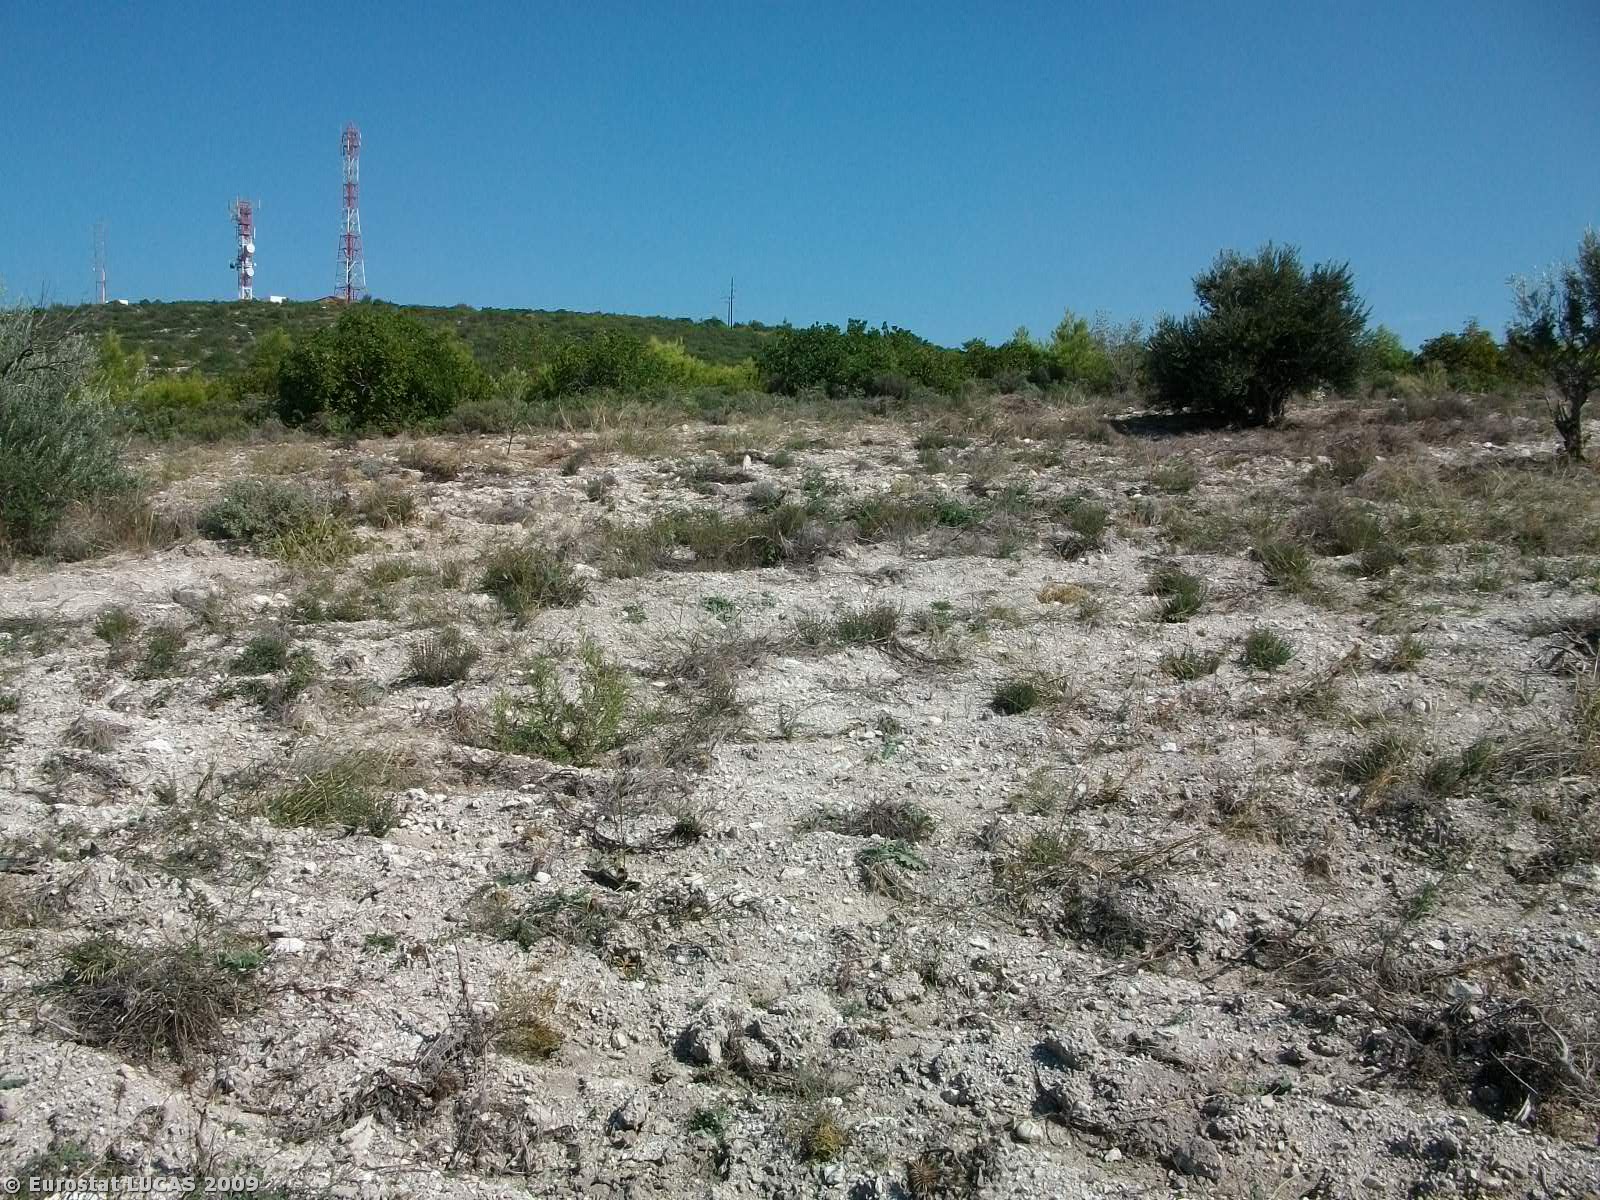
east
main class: Cropland
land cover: Olive groves
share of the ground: < 10 %
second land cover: Grassland with sparse tree/shrub cover
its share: 50 - 75 %
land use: Agriculture (excluding fallow land and kitchen gardens)
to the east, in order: Olive groves; Grassland with sparse tree/shrub cover; Mixed woodland; Paved roads, cycling and walking lanes; Abandoned hedges; Grassland with sparse tree/shrub cover; Broadleaved woodland
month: September
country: GR
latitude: 38.2742
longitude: 23.8285
